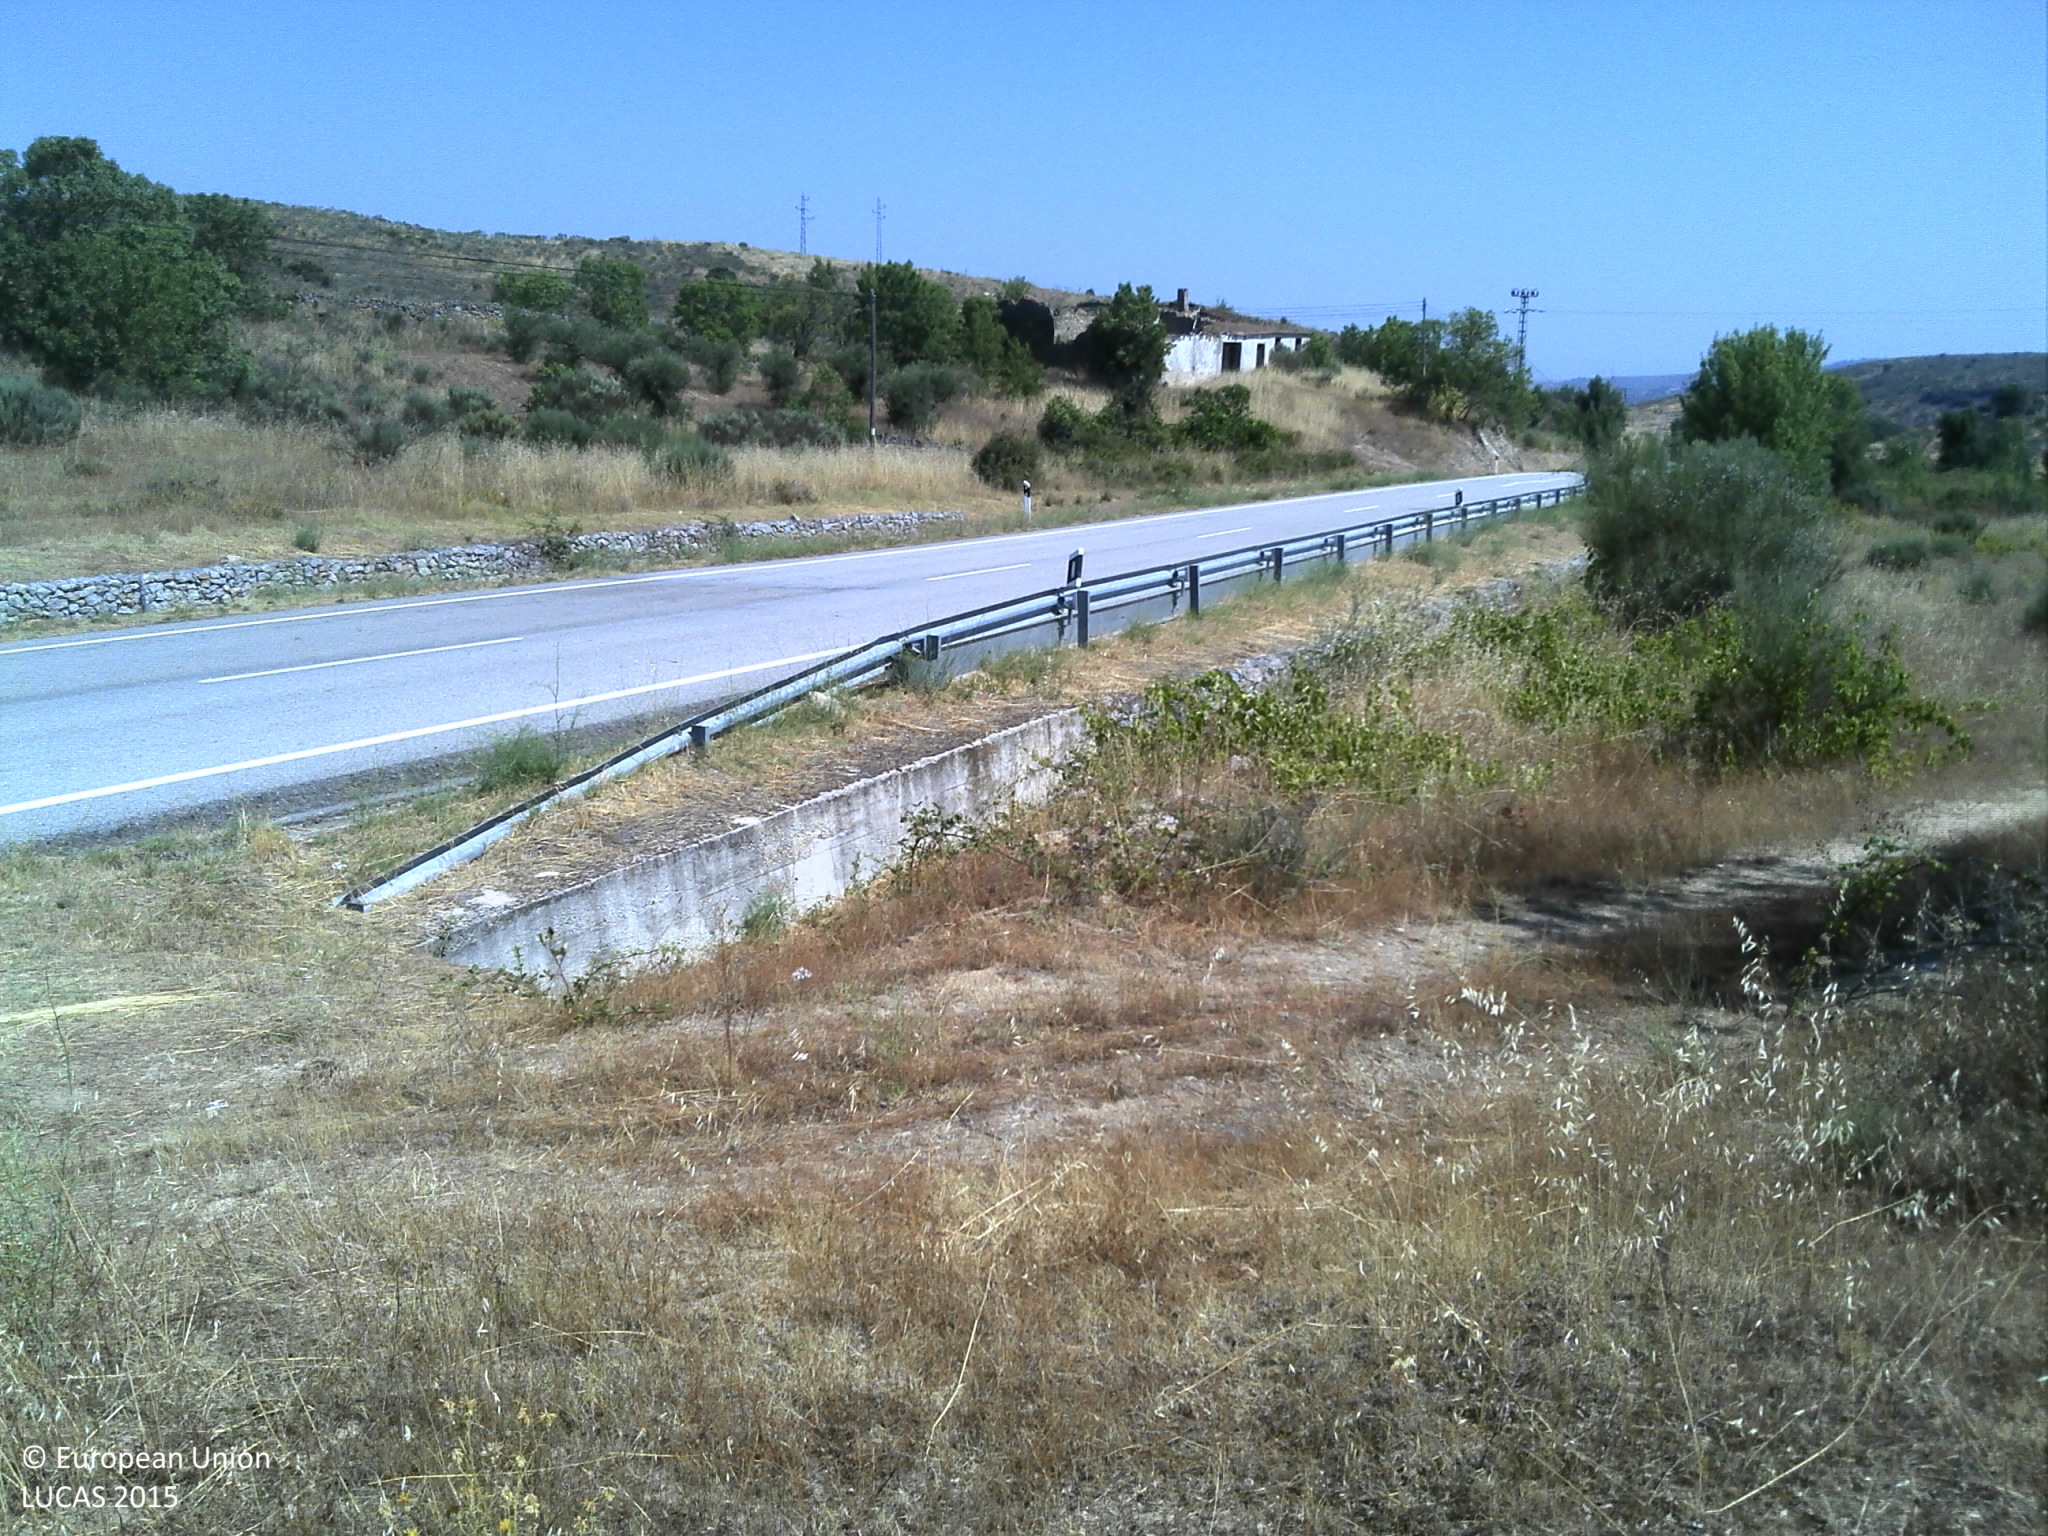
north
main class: Shrubland
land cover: Shrubland with sparse tree cover
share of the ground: > 75 %
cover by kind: shrubs 95 %, broadleaved forest trees 5 %
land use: Semi-natural and natural areas not in use
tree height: < 5 m
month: July
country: PT
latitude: 40.9300
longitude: -7.2001
